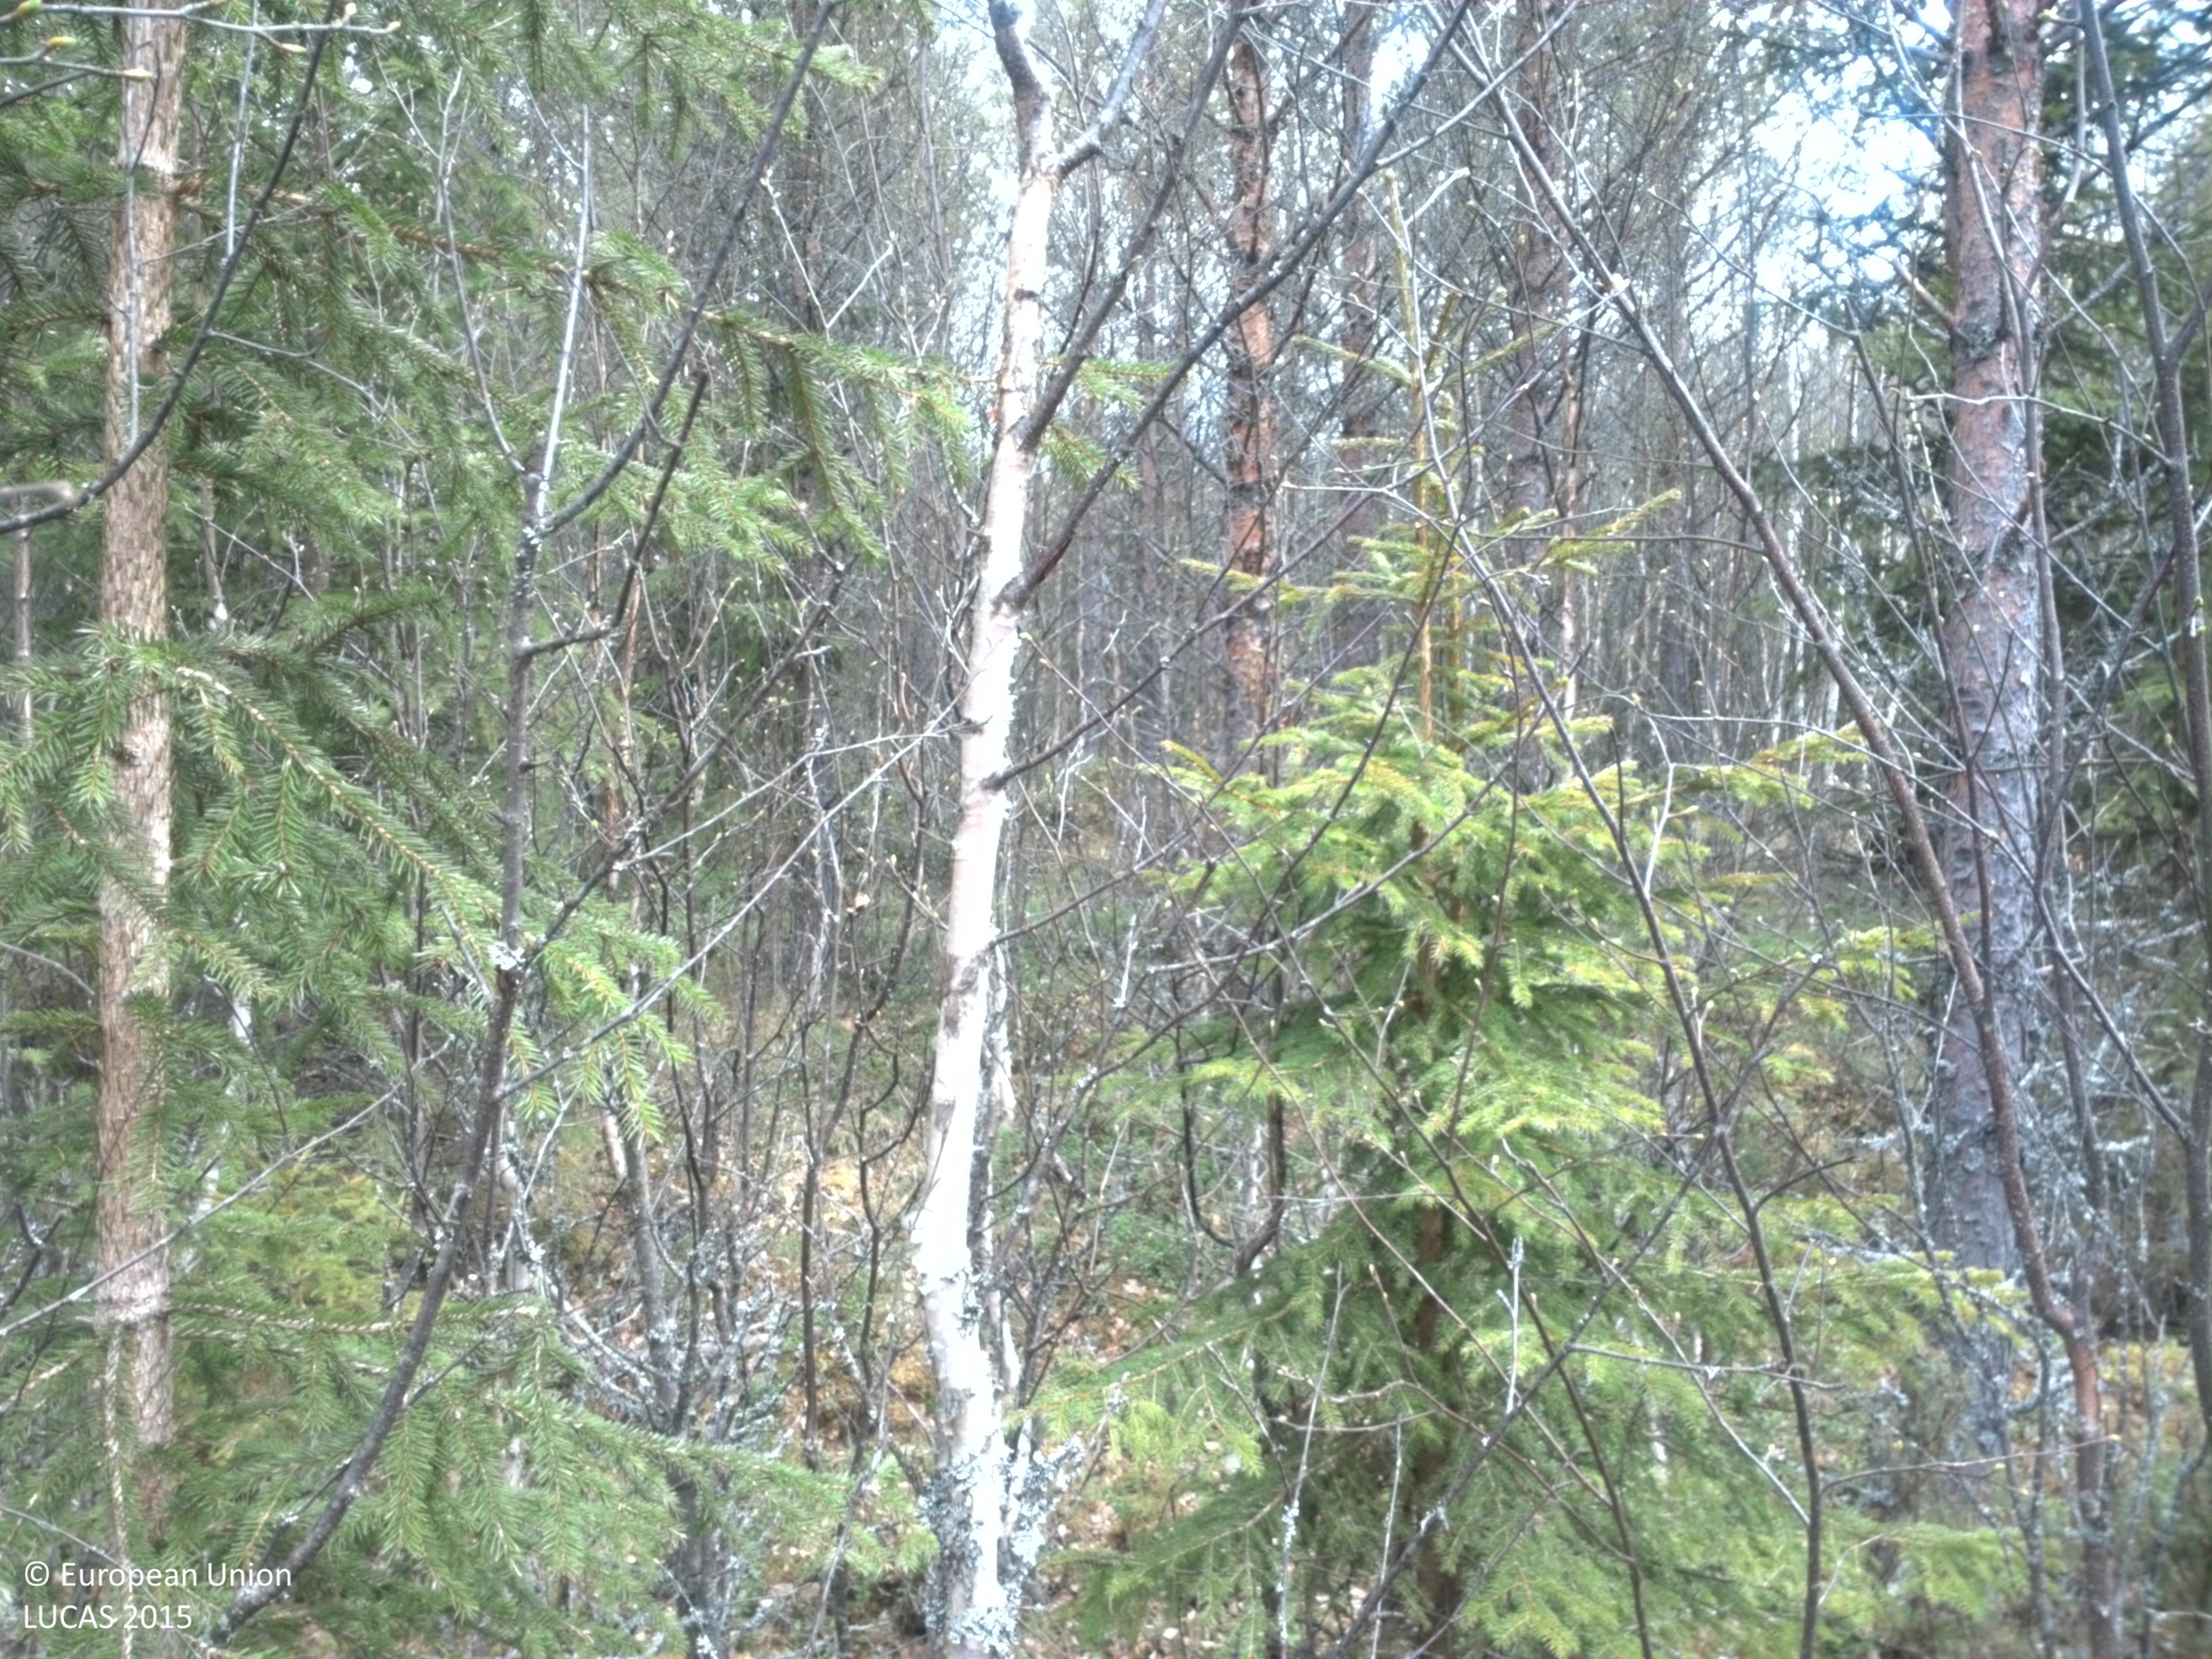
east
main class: Woodland
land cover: Other mixed woodland
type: boreal forest
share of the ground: > 75 %
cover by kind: broadleaved forest trees 40 %, coniferous forest trees 35 %, herbaceous plants 20 %, shrubs 5 %
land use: Forestry
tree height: > 5 m
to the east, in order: Other mixed woodland; Pine dominated mixed woodland; Other mixed woodland; Spruce dominated mixed woodland; Other mixed woodland; Rivers and streams
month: May
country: SE
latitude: 63.3224
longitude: 15.0678
